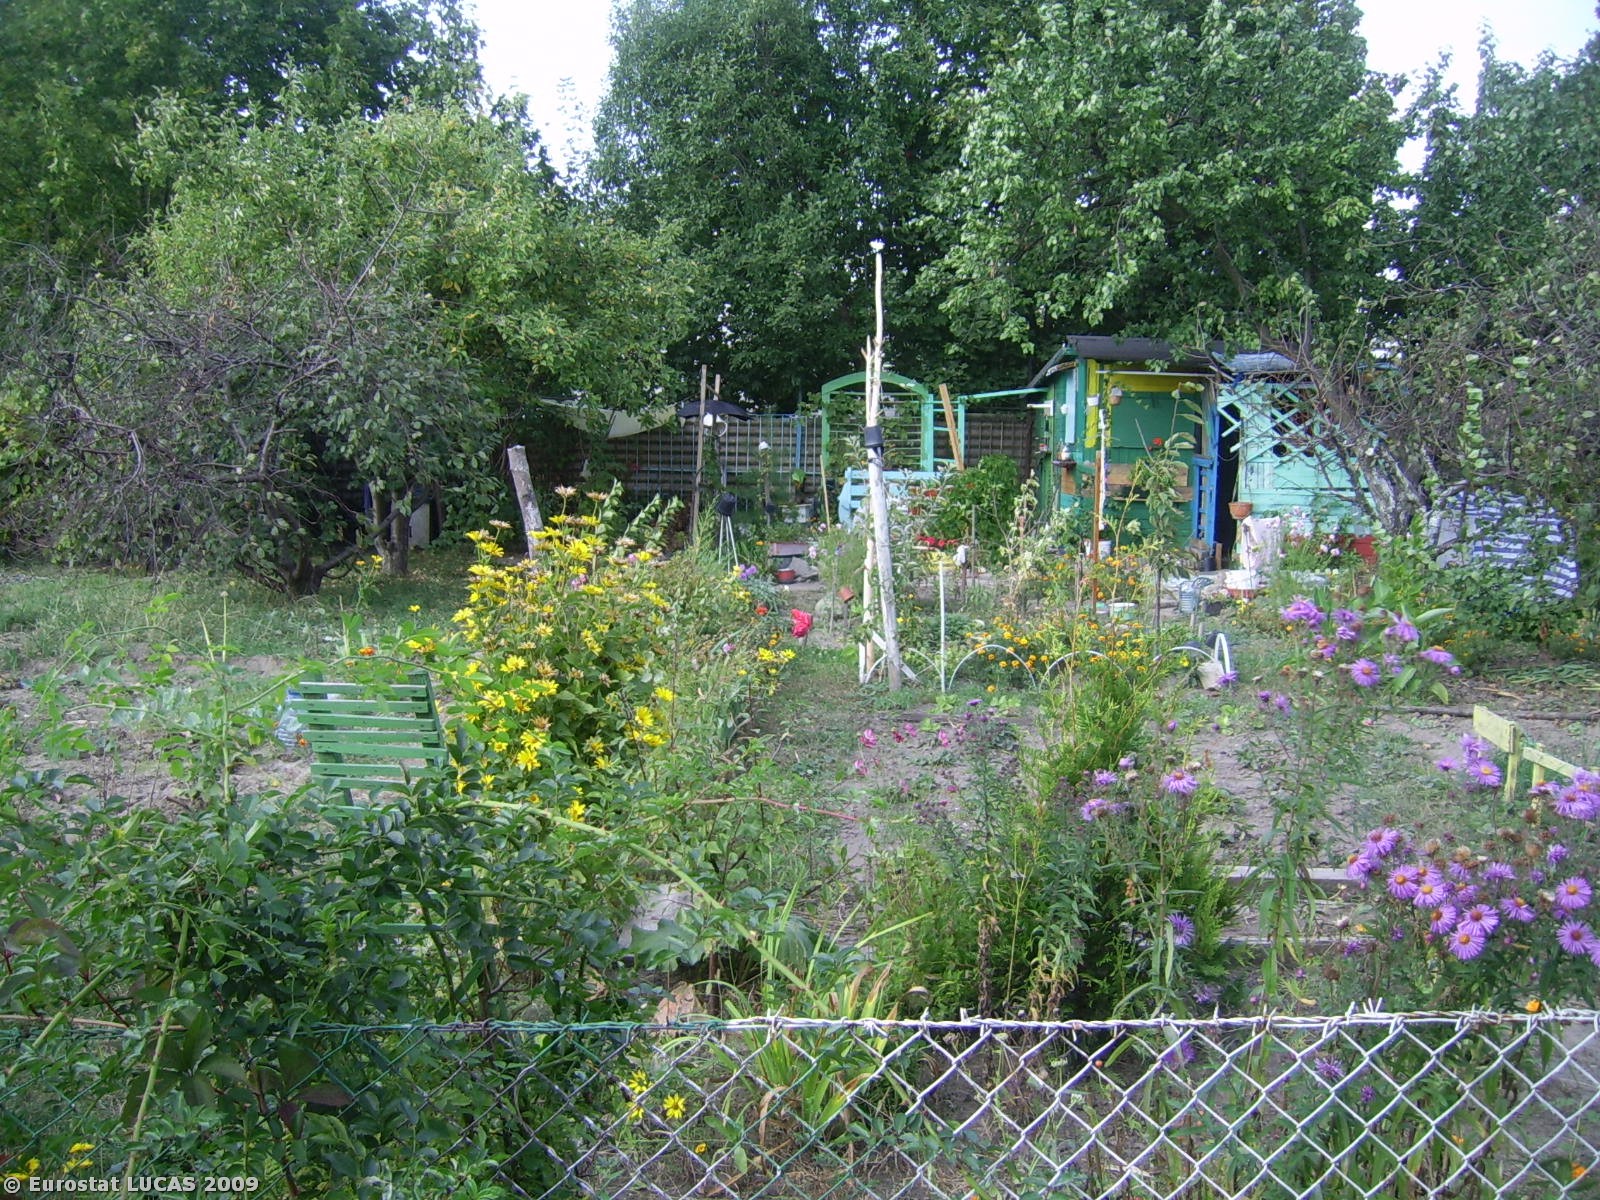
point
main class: Cropland
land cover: Floriculture and ornamental plants
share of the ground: 50 - 75 %
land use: Amenities, museums, leisure
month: September
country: PL
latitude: 52.3718
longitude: 16.9571
